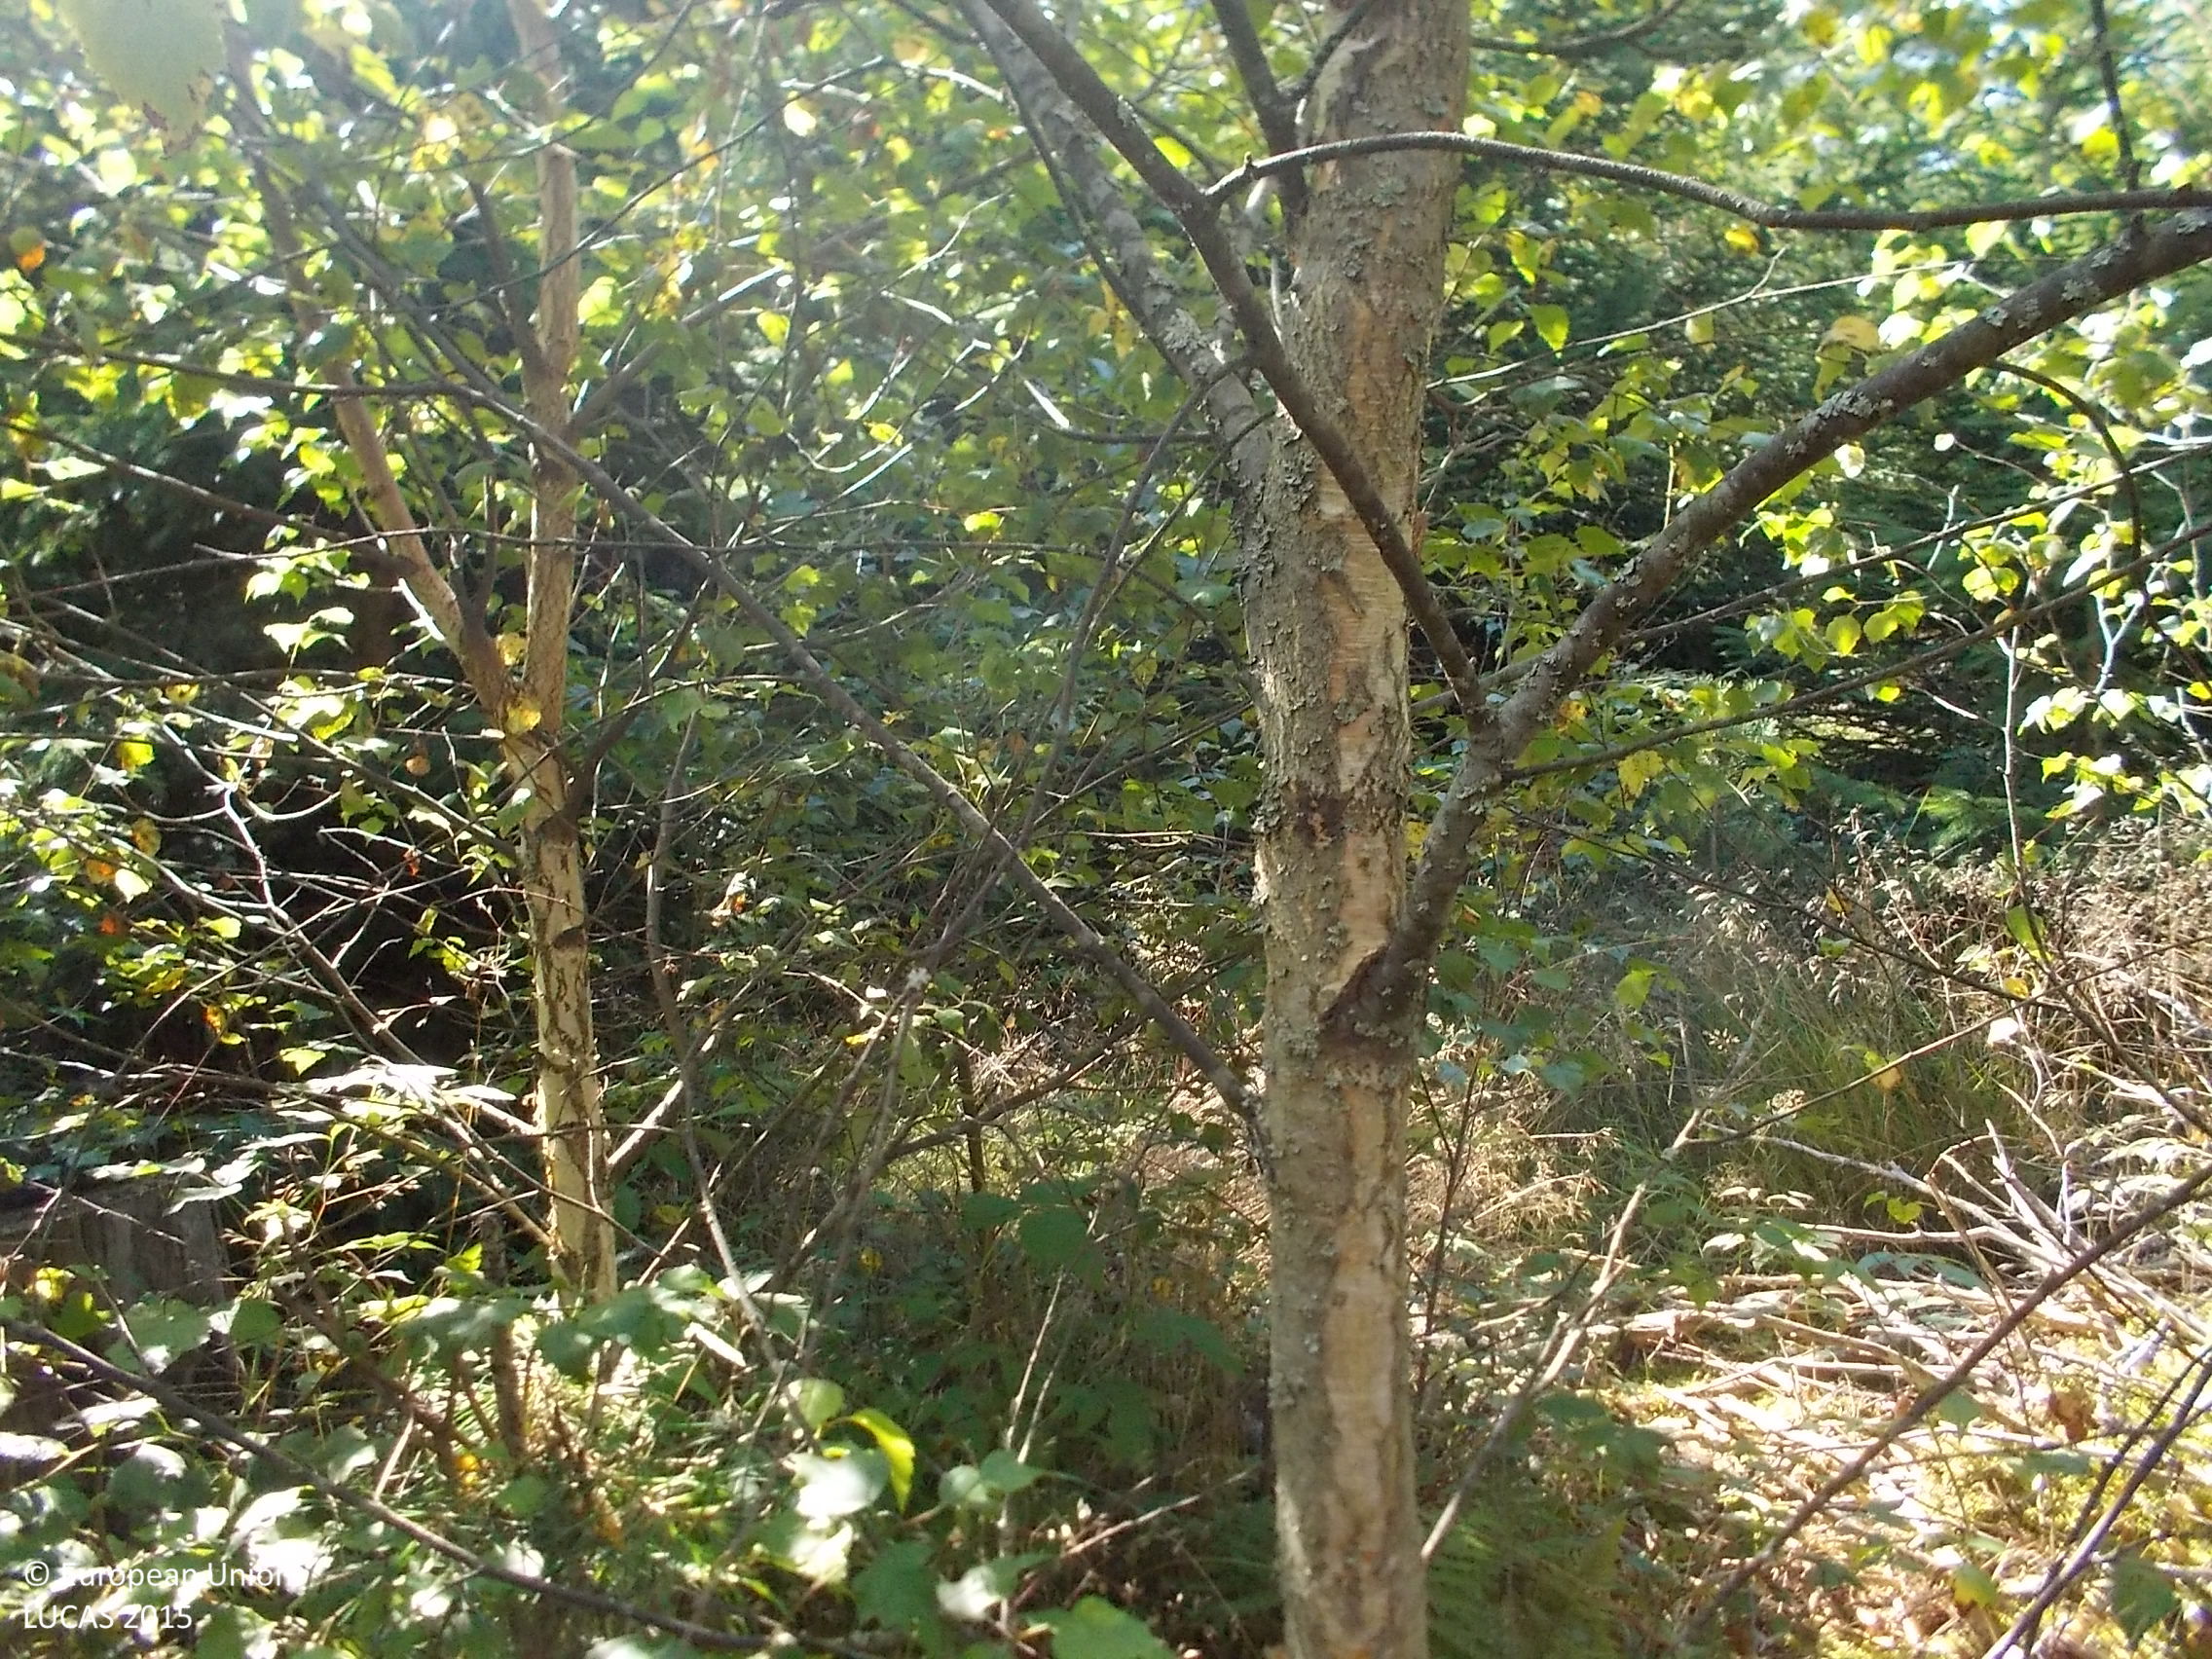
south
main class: Woodland
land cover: Spruce dominated mixed woodland
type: boreal forest
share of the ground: > 75 %
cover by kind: coniferous forest trees 45 %, broadleaved forest trees 40 %, herbaceous plants 10 %, lichens and mosses 5 %
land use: Forestry
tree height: < 5 m
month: August
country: SE
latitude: 57.4612
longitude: 13.2129
